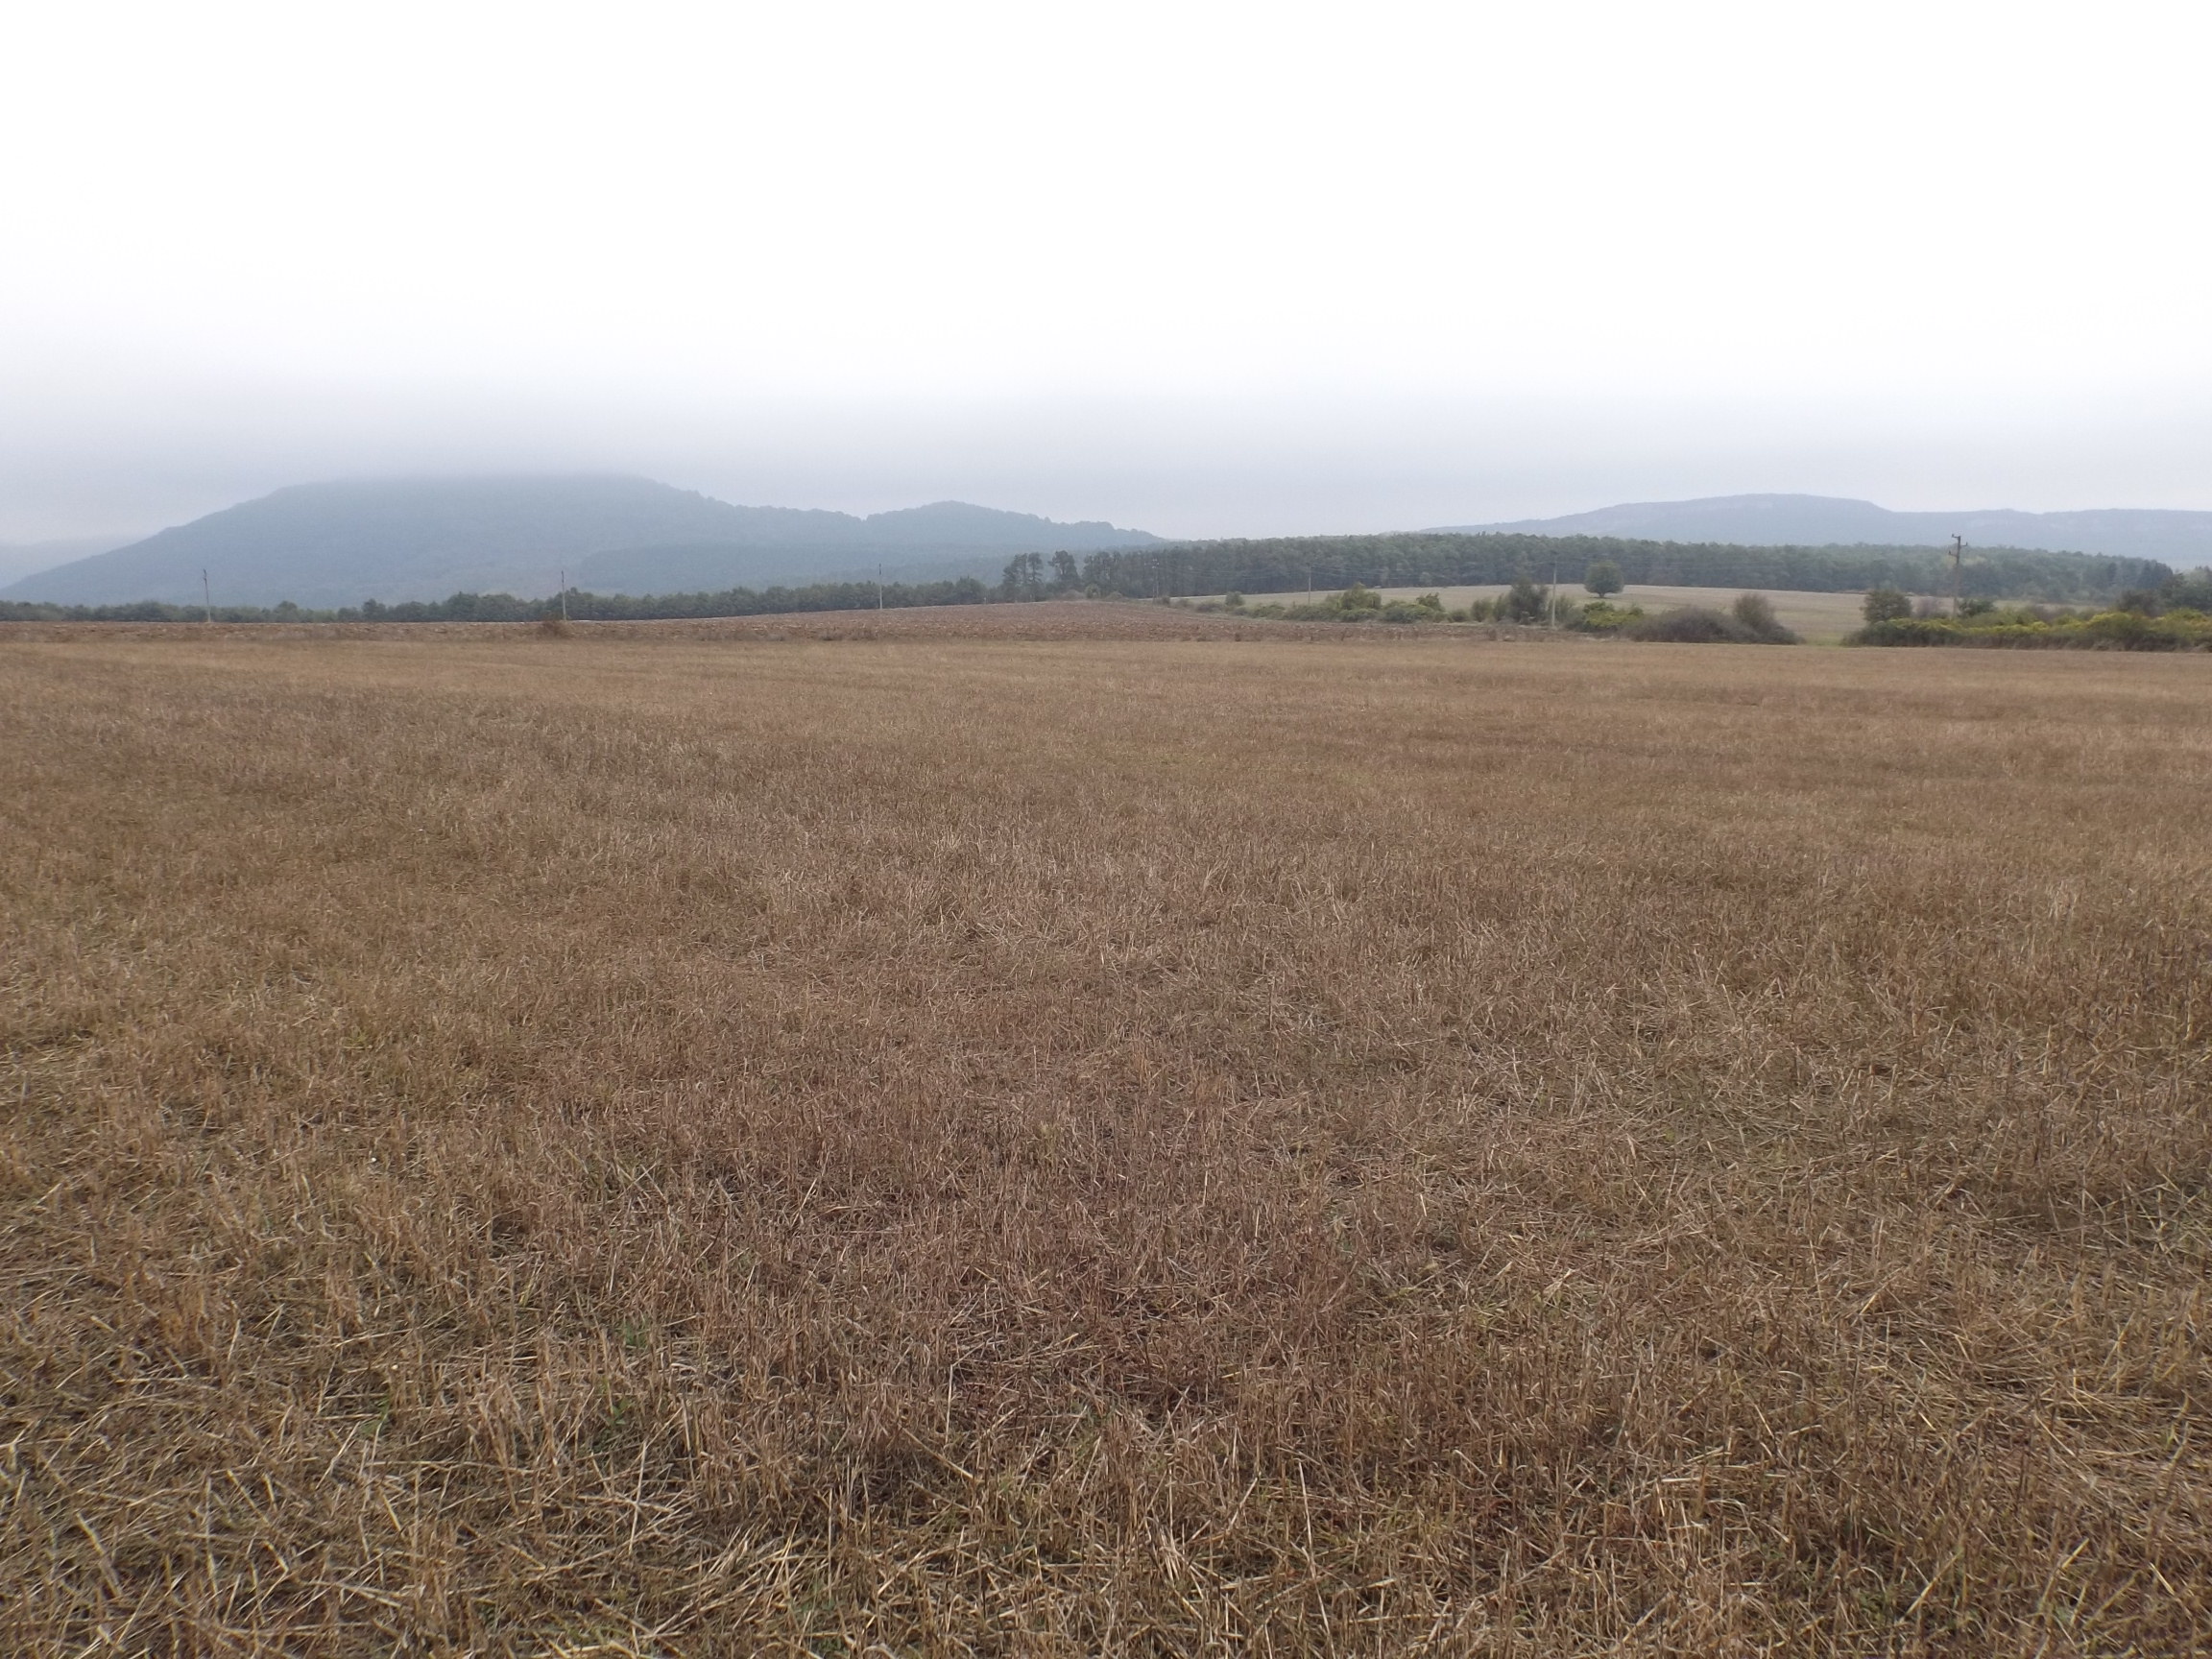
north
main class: Cropland
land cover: Common wheat
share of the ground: 25 - 50 %
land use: Agriculture (excluding fallow land and kitchen gardens)
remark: Harvested field
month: October
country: BG
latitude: 43.0063
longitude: 27.2312
